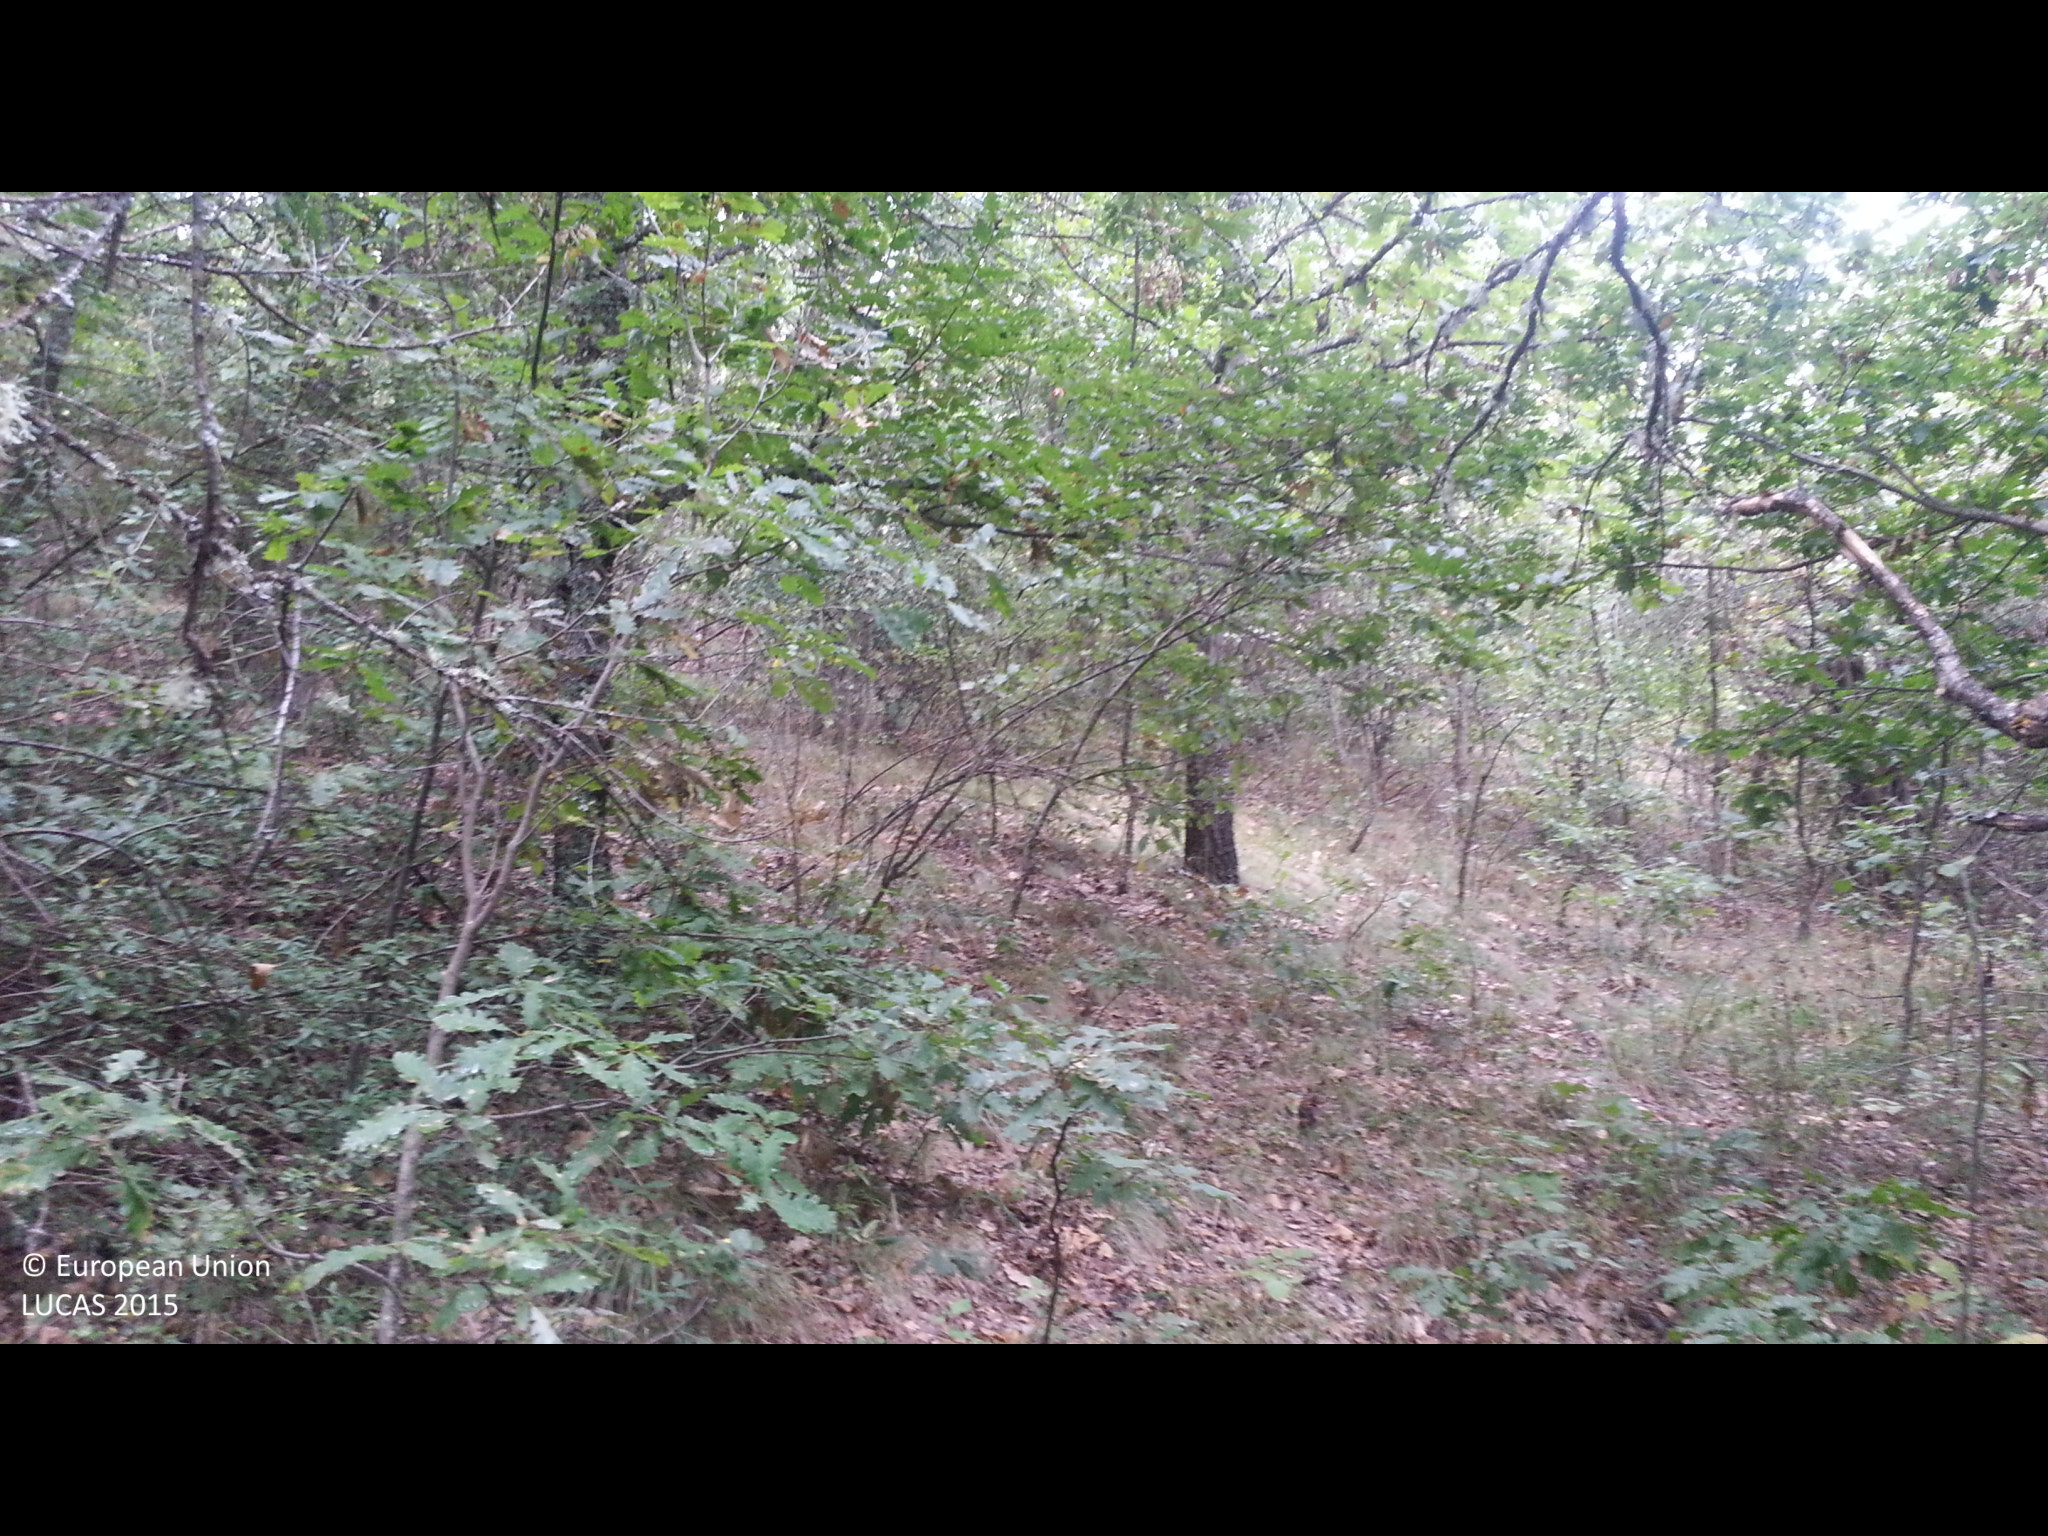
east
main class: Woodland
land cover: Broadleaved woodland
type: mesophytic deciduous forest
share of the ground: > 75 %
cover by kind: broadleaved forest trees 90 %, shrubs 10 %
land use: Forestry
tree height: > 5 m
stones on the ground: < 10 %
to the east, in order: Broadleaved woodland; Shrubland with sparse tree cover; Broadleaved woodland; Artificial constructions in urban areas; Broadleaved woodland
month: September
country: BG
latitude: 42.3643
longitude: 22.5393
